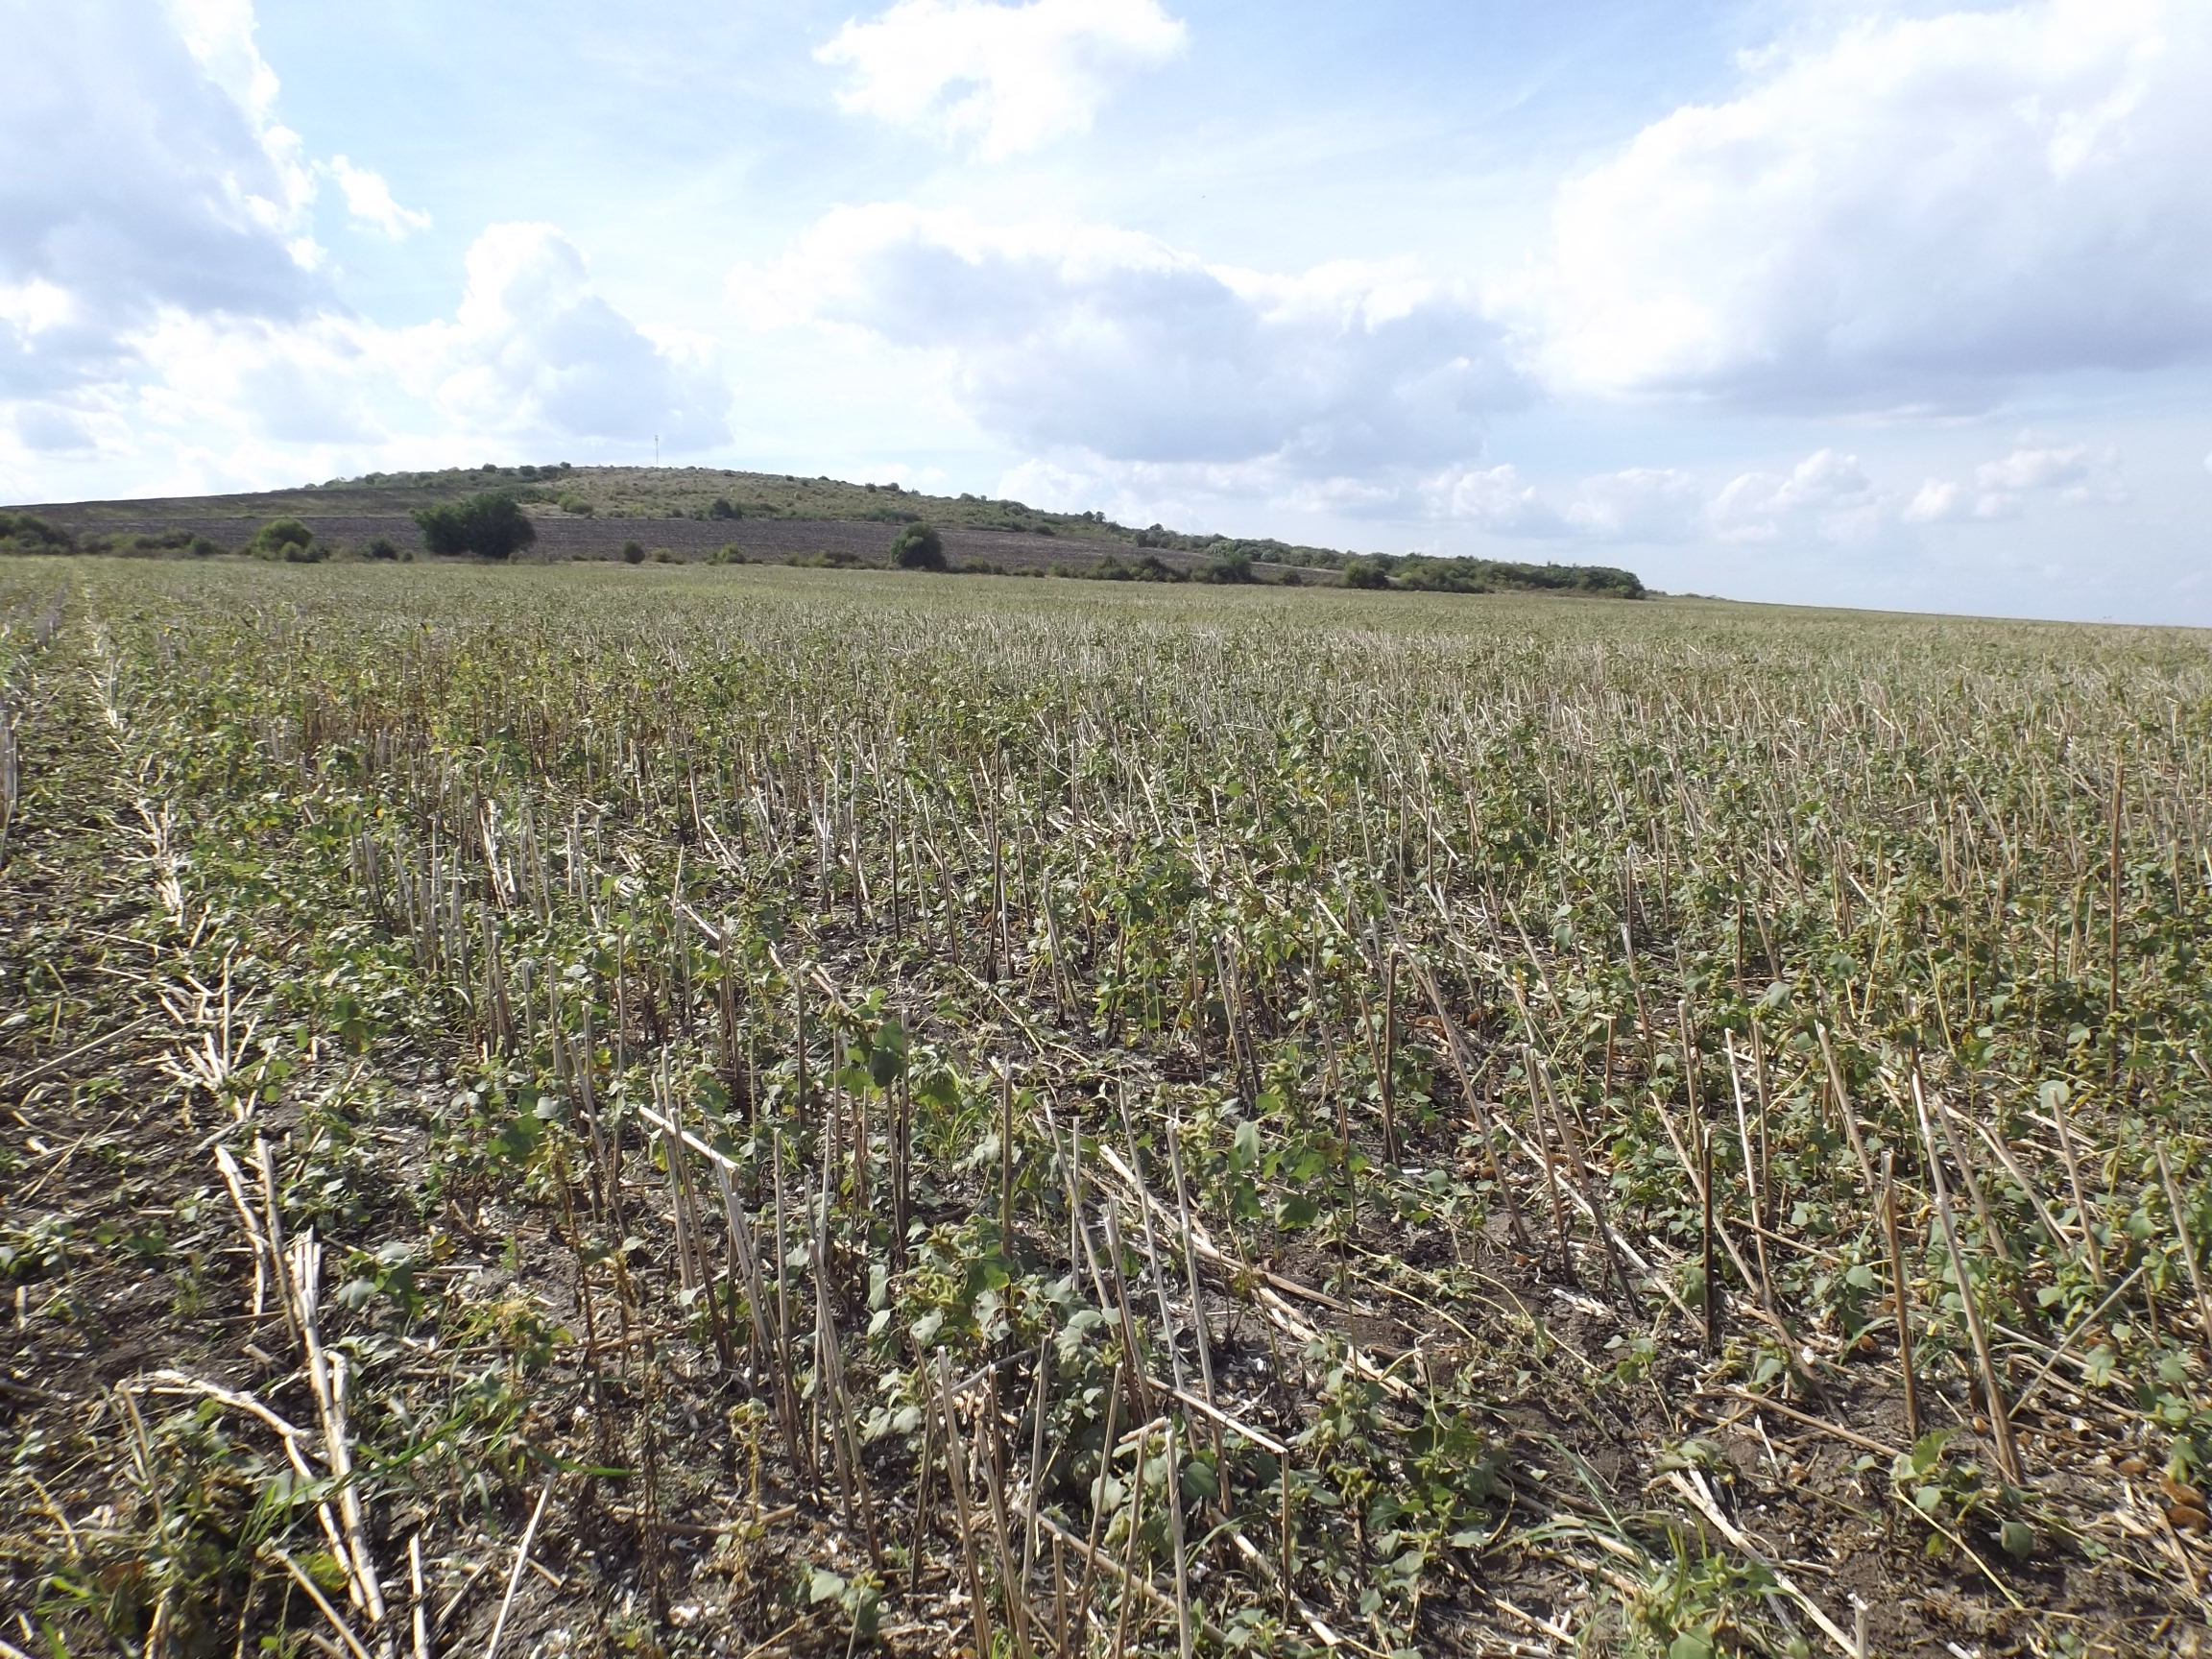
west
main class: Cropland
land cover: Sunflower
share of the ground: < 10 %
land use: Agriculture (excluding fallow land and kitchen gardens)
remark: Harvested field
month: September
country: BG
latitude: 43.2832
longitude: 27.4411
